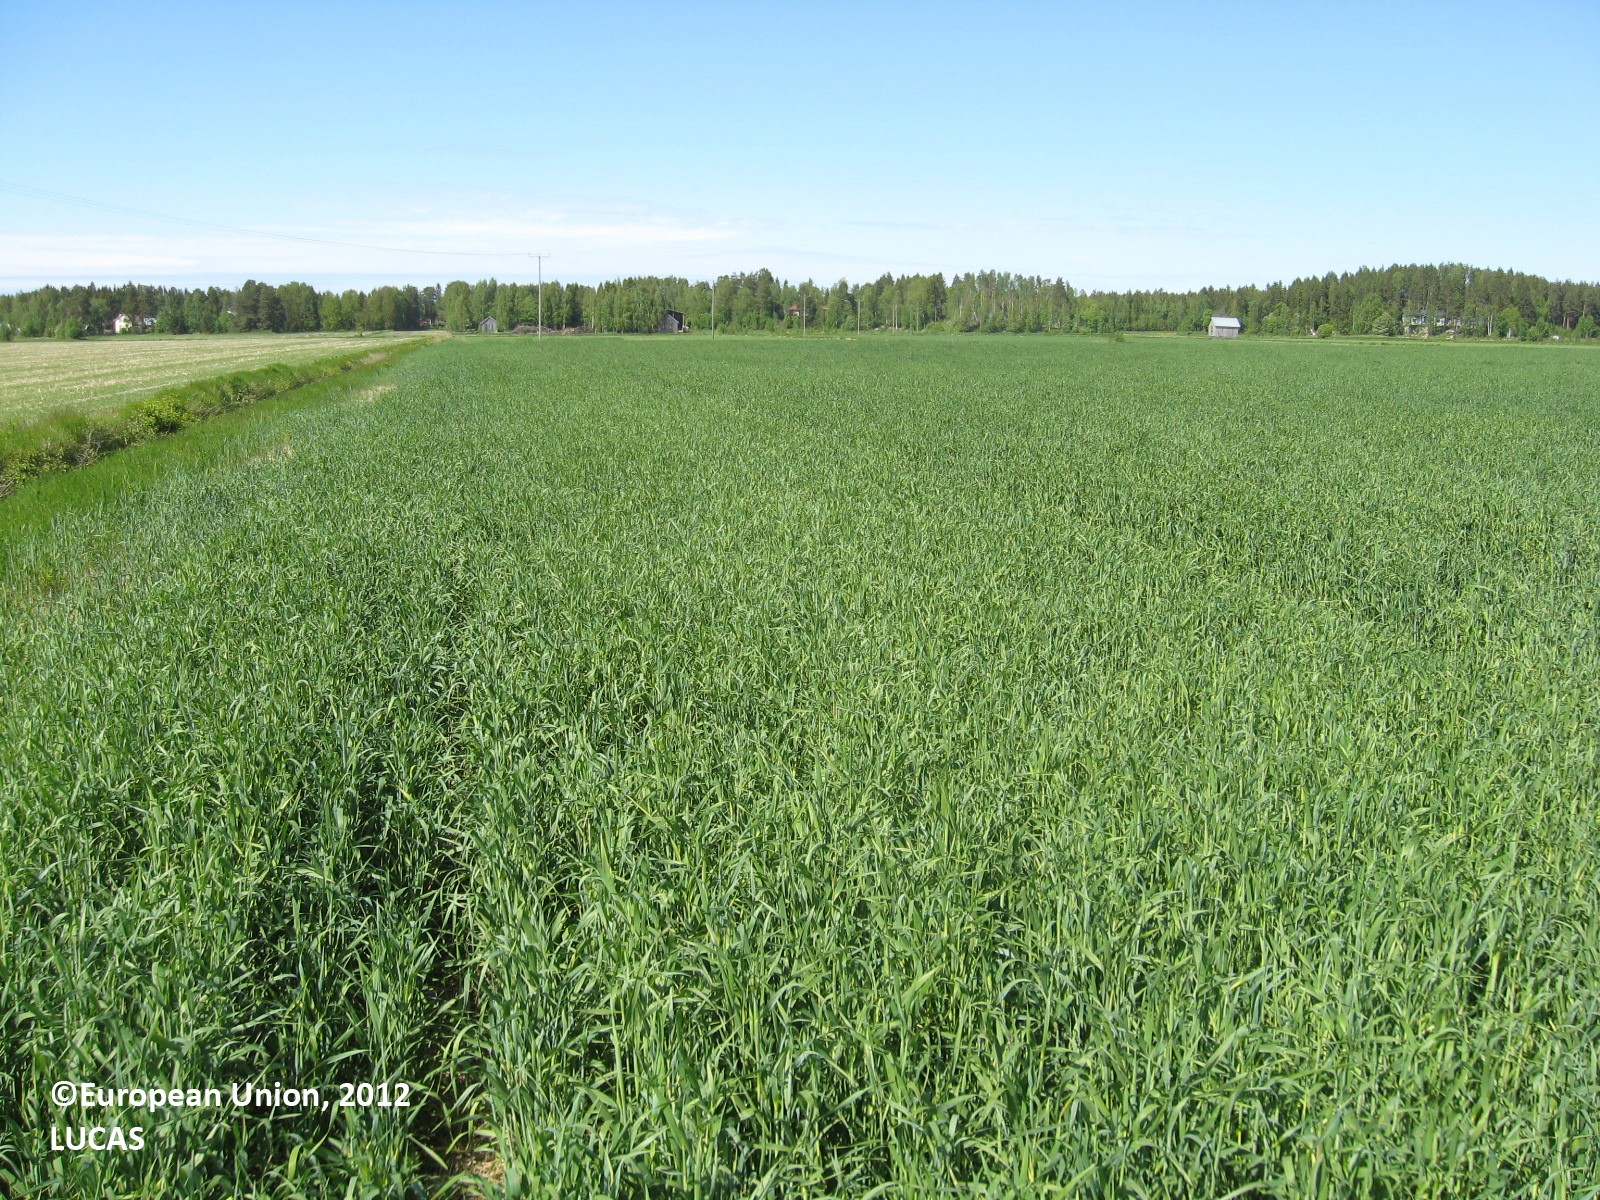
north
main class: Cropland
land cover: Rye
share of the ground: > 75 %
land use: Agriculture (excluding fallow land and kitchen gardens)
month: June
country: FI
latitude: 63.1833
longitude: 21.8637
